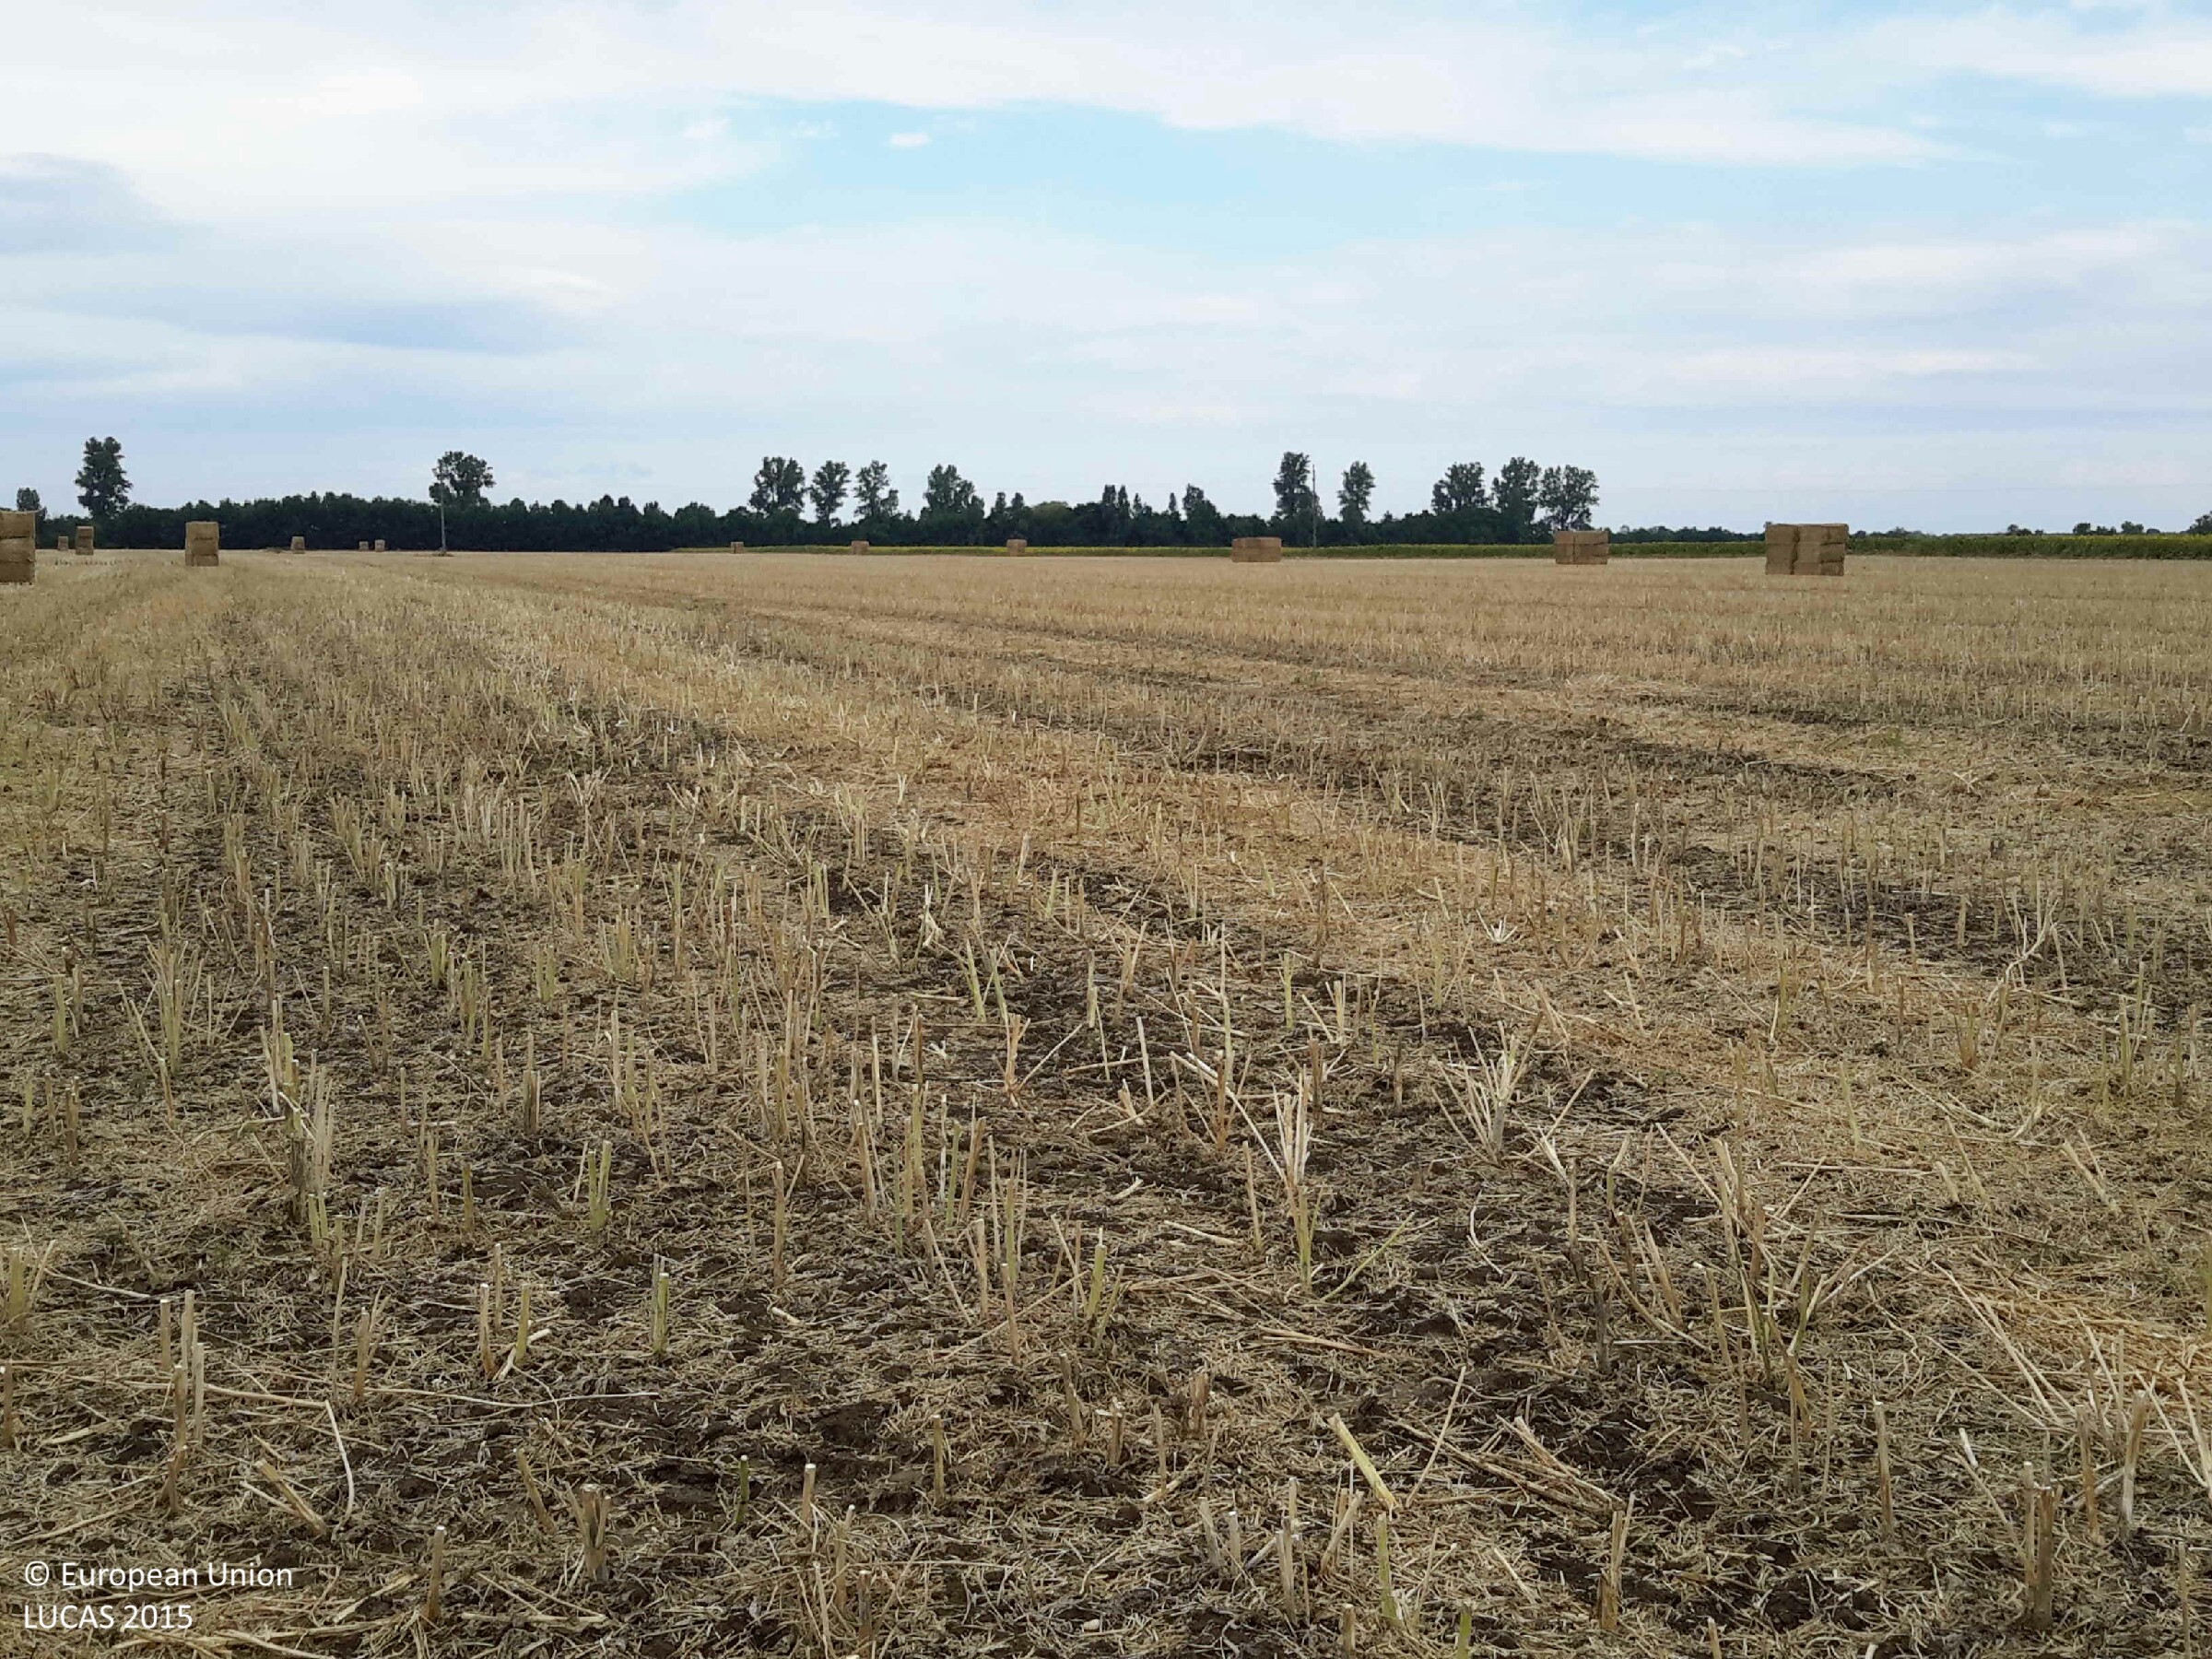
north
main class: Cropland
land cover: Rape and turnip rape
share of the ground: < 10 %
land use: Agriculture (excluding fallow land and kitchen gardens)
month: July
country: HU
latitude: 47.4437
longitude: 17.2339
